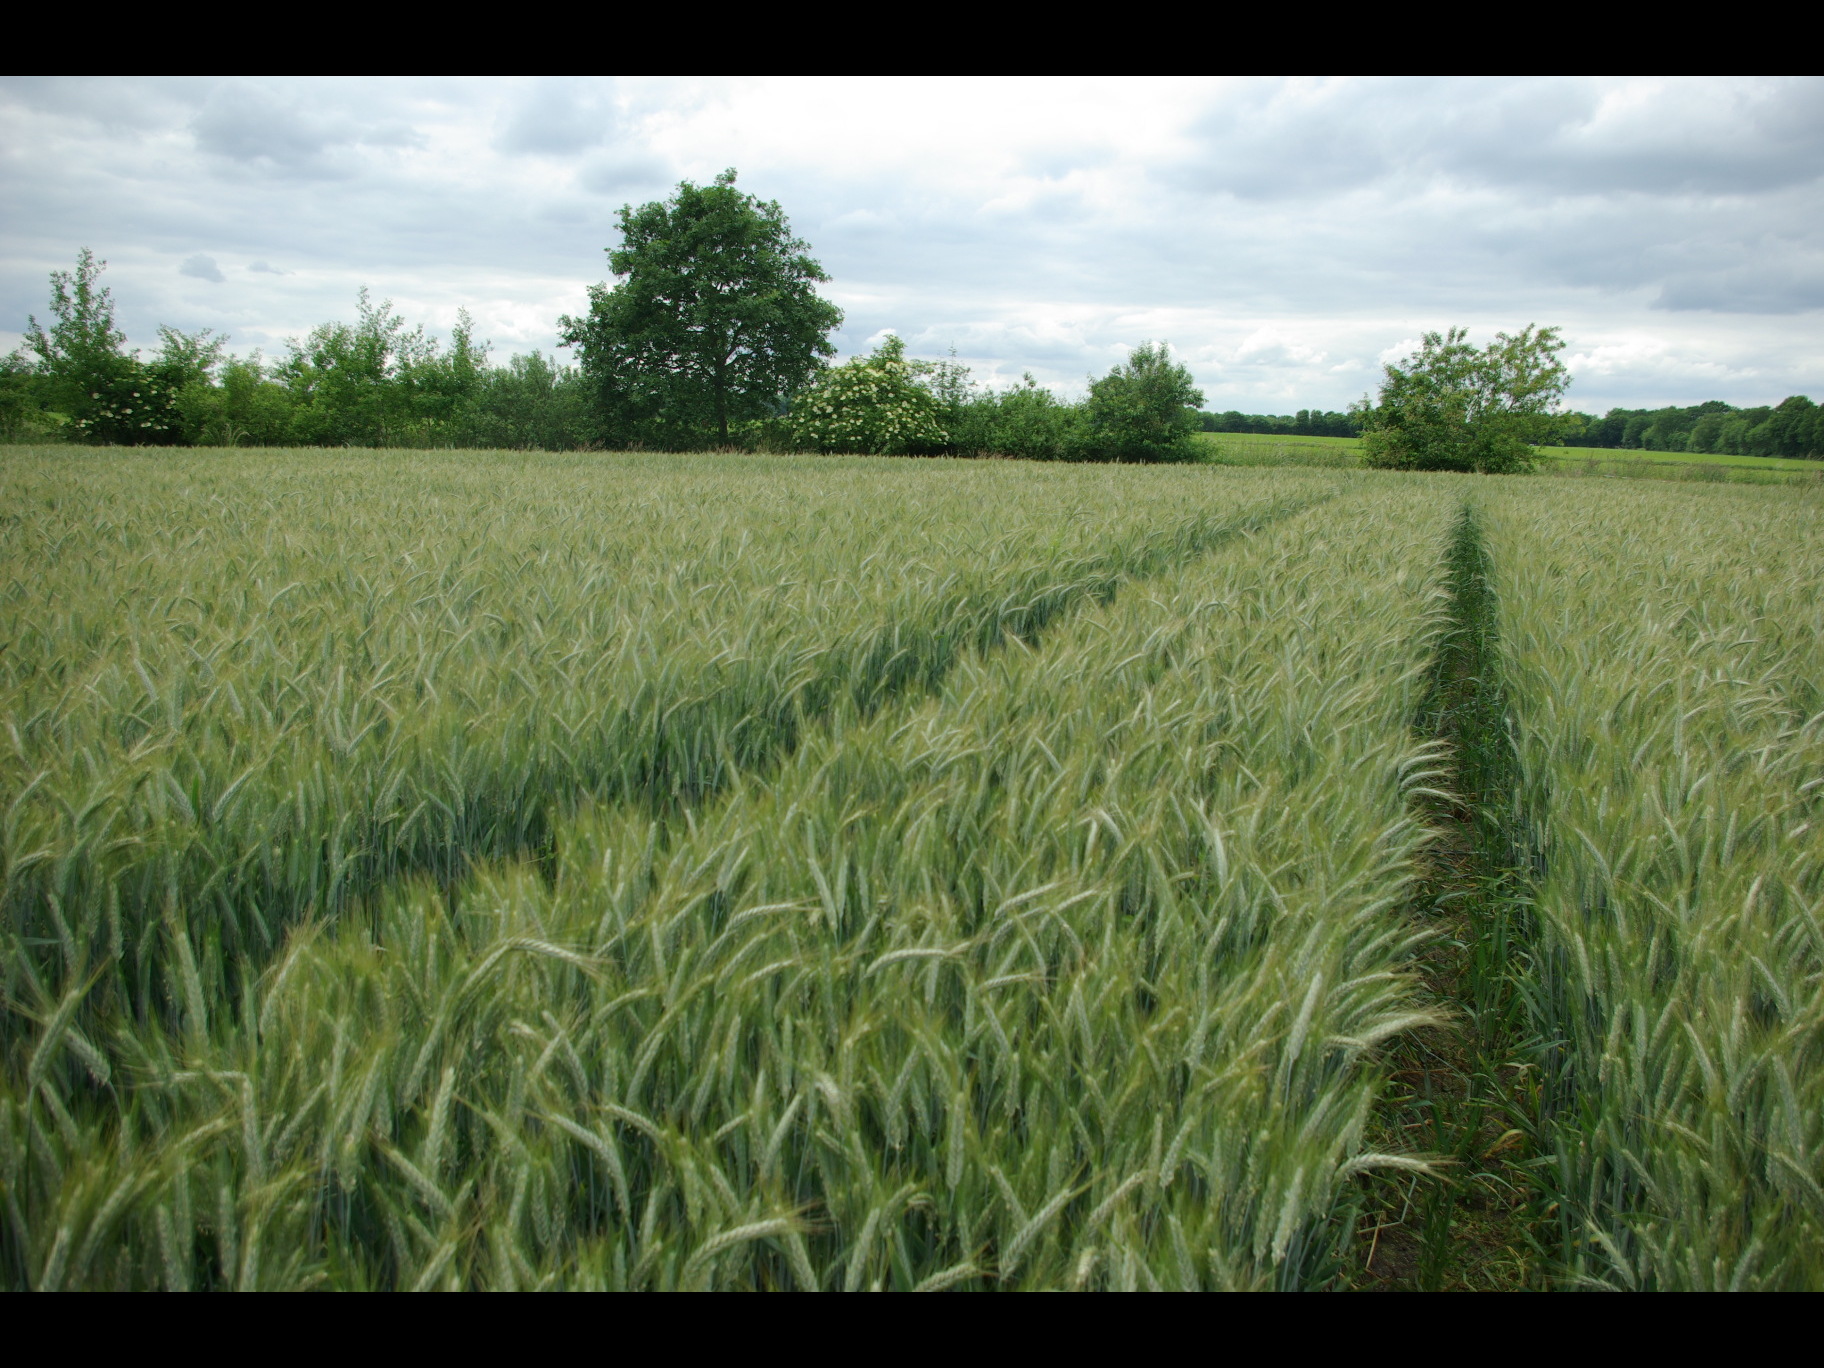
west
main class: Cropland
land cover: Triticale
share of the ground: > 75 %
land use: Agriculture (excluding fallow land and kitchen gardens)
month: June
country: DE
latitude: 54.1028
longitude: 9.9236
